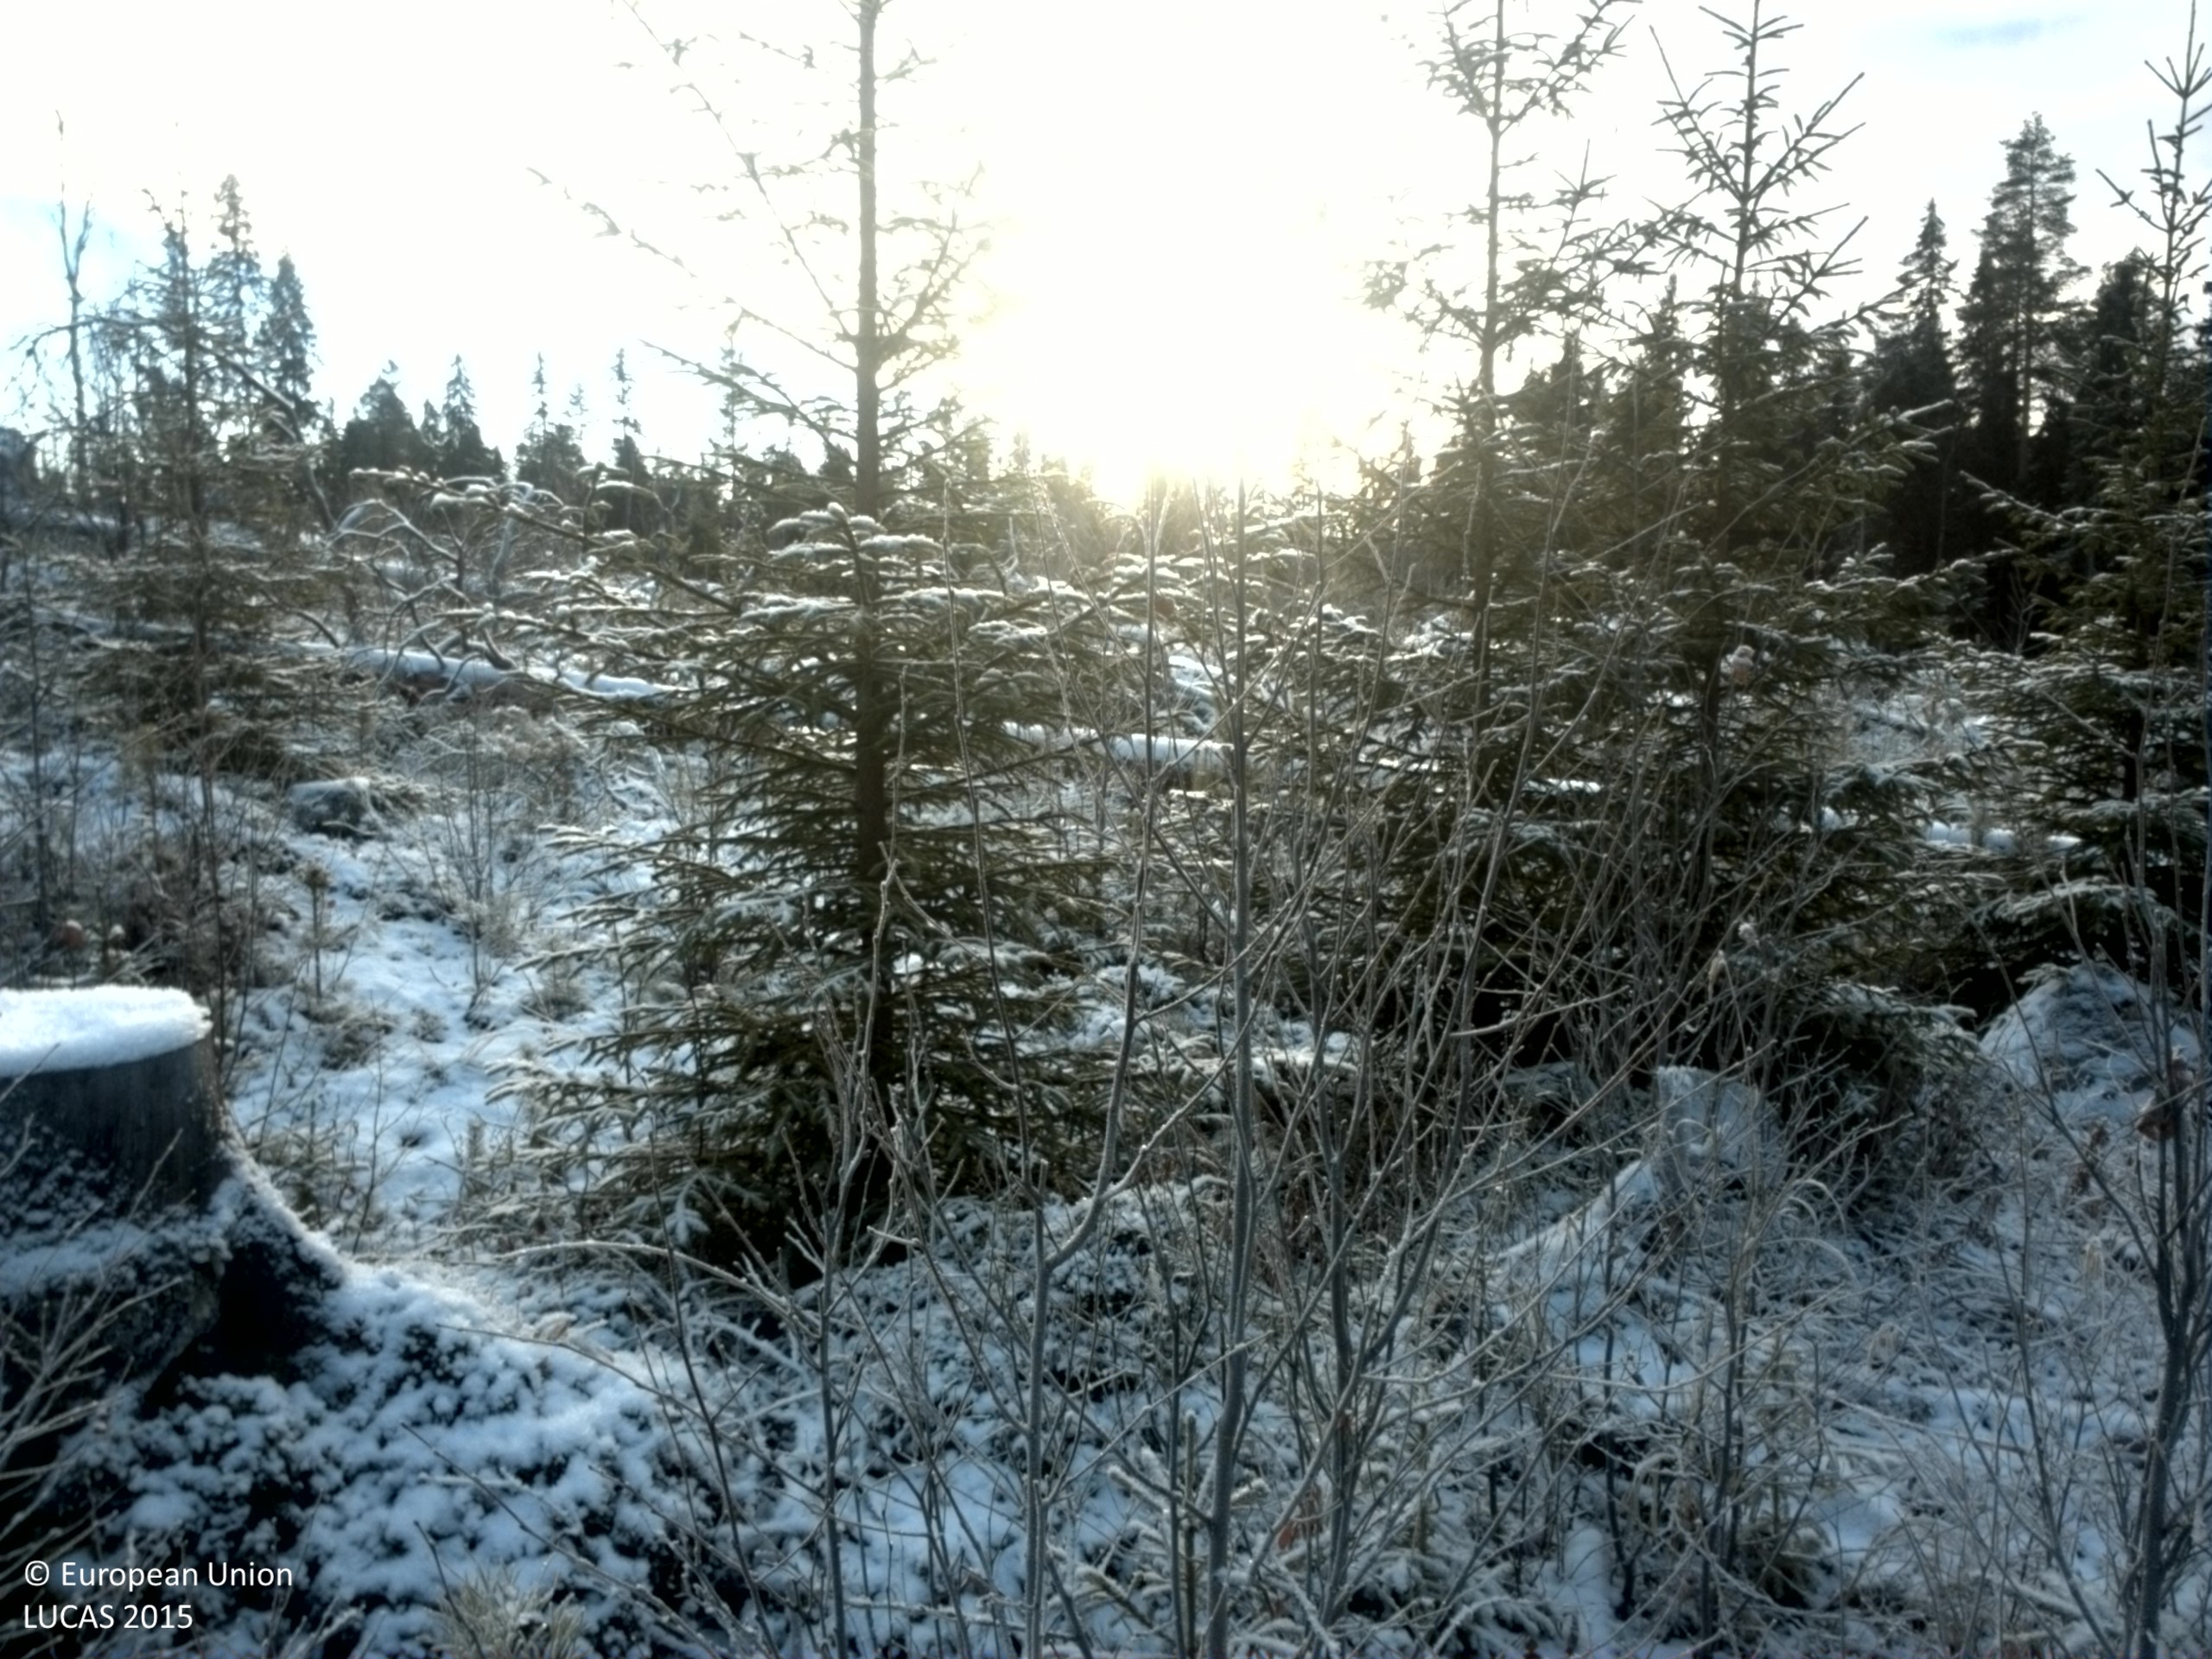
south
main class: Woodland
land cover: Other mixed woodland
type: boreal forest
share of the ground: 25 - 50 %
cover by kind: shrubs 40 %, lichens and mosses 25 %, broadleaved forest trees 20 %, coniferous forest trees 15 %
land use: Forestry
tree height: < 5 m
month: November
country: SE
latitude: 62.0127
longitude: 15.3114
